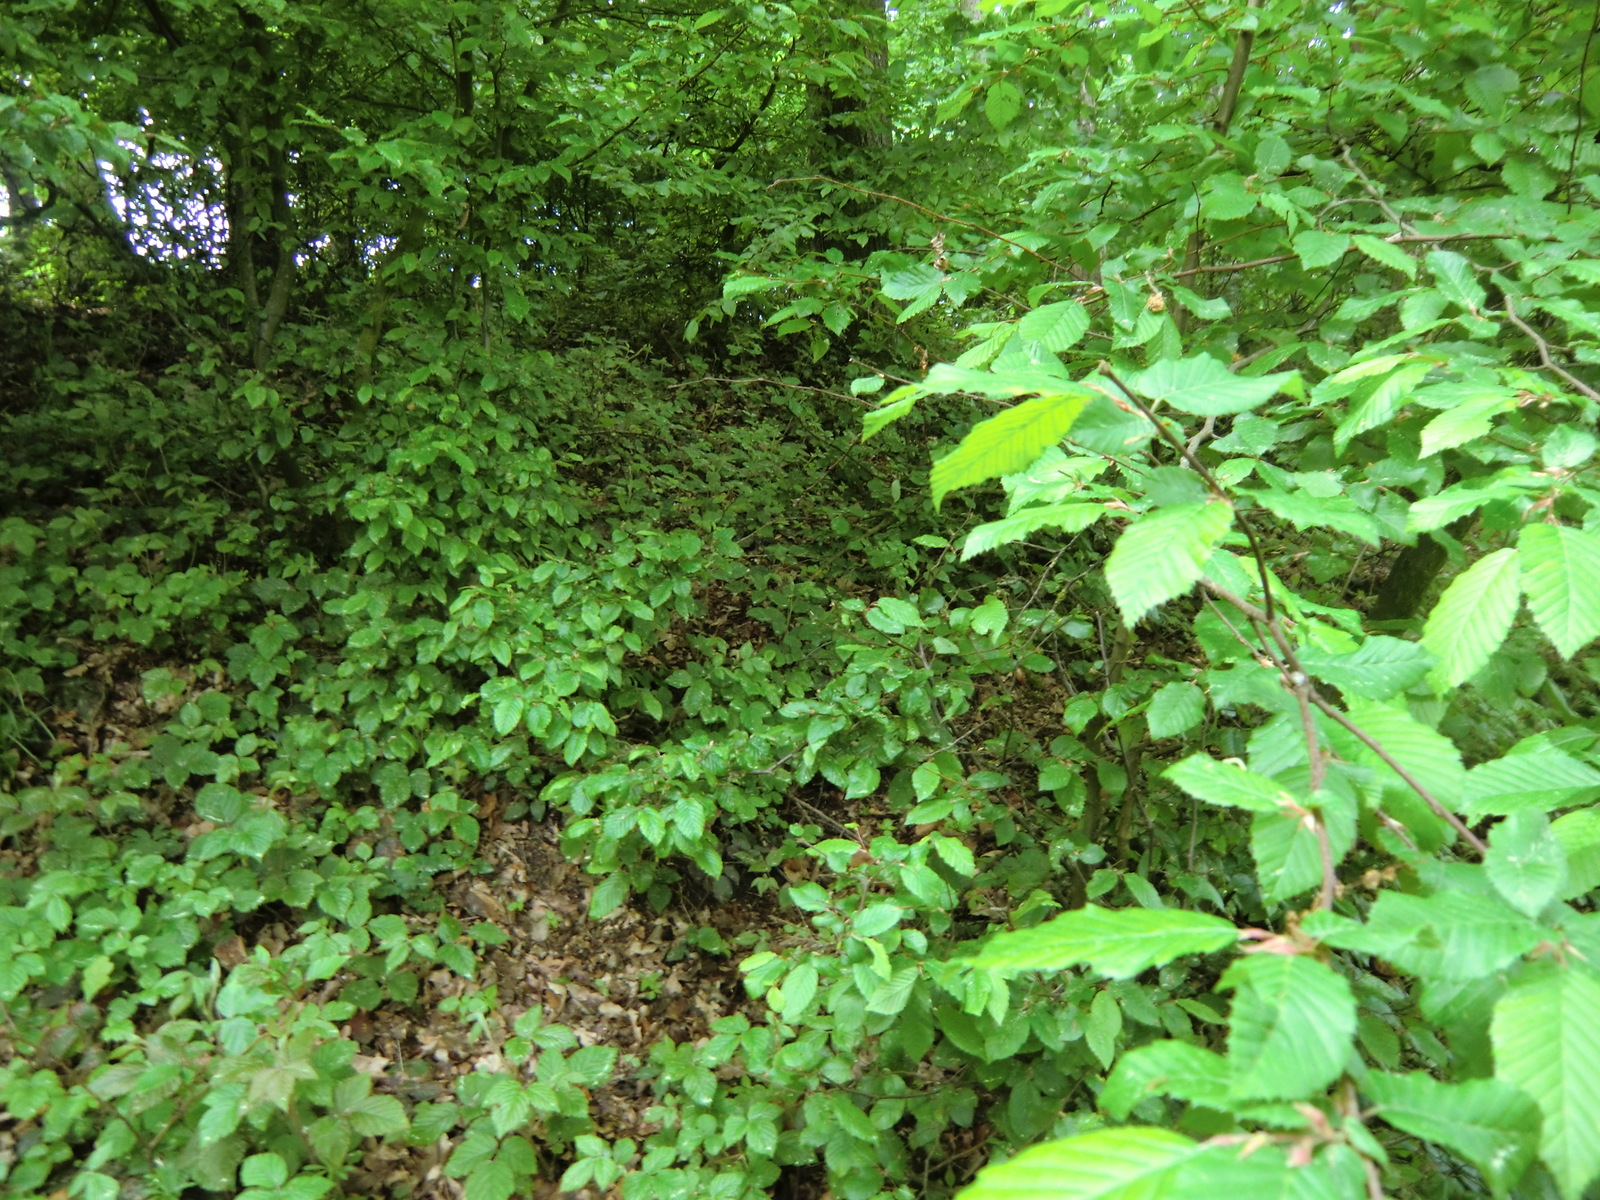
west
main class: Woodland
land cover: Spruce dominated mixed woodland
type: mountainous beech forest
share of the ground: > 75 %
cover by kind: broadleaved forest trees 30 %, shrubs 30 %, coniferous forest trees 20 %, herbaceous plants 10 %, unconsolidated bare surface 10 %
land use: Forestry
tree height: > 5 m
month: May
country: AT
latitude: 48.2709
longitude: 14.6219
